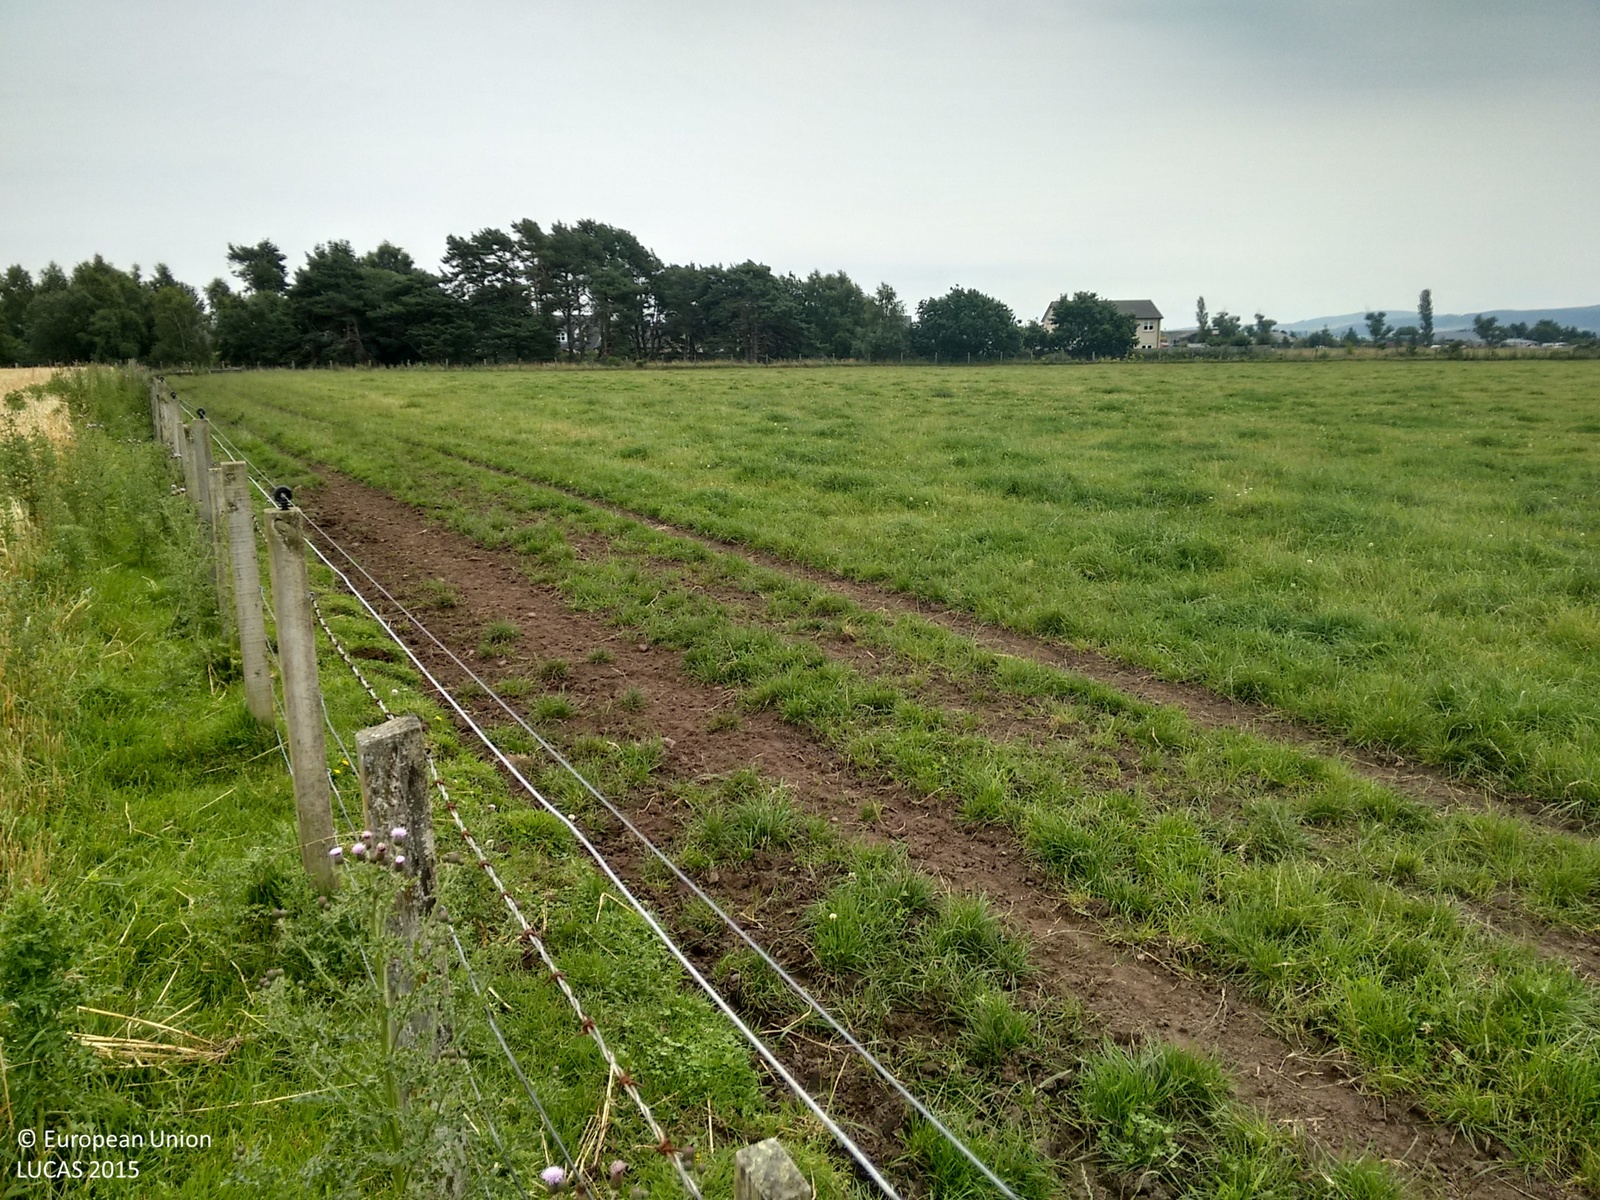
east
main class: Cropland
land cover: Barley
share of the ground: > 75 %
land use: Agriculture (excluding fallow land and kitchen gardens)
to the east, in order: Fences; Grassland without tree/shrub cover; Fences; Grassland without tree/shrub cover; Railways; Pine dominated coniferous woodland; Artificial constructions in urban areas
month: August
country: GB
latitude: 57.5048
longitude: -4.4597
